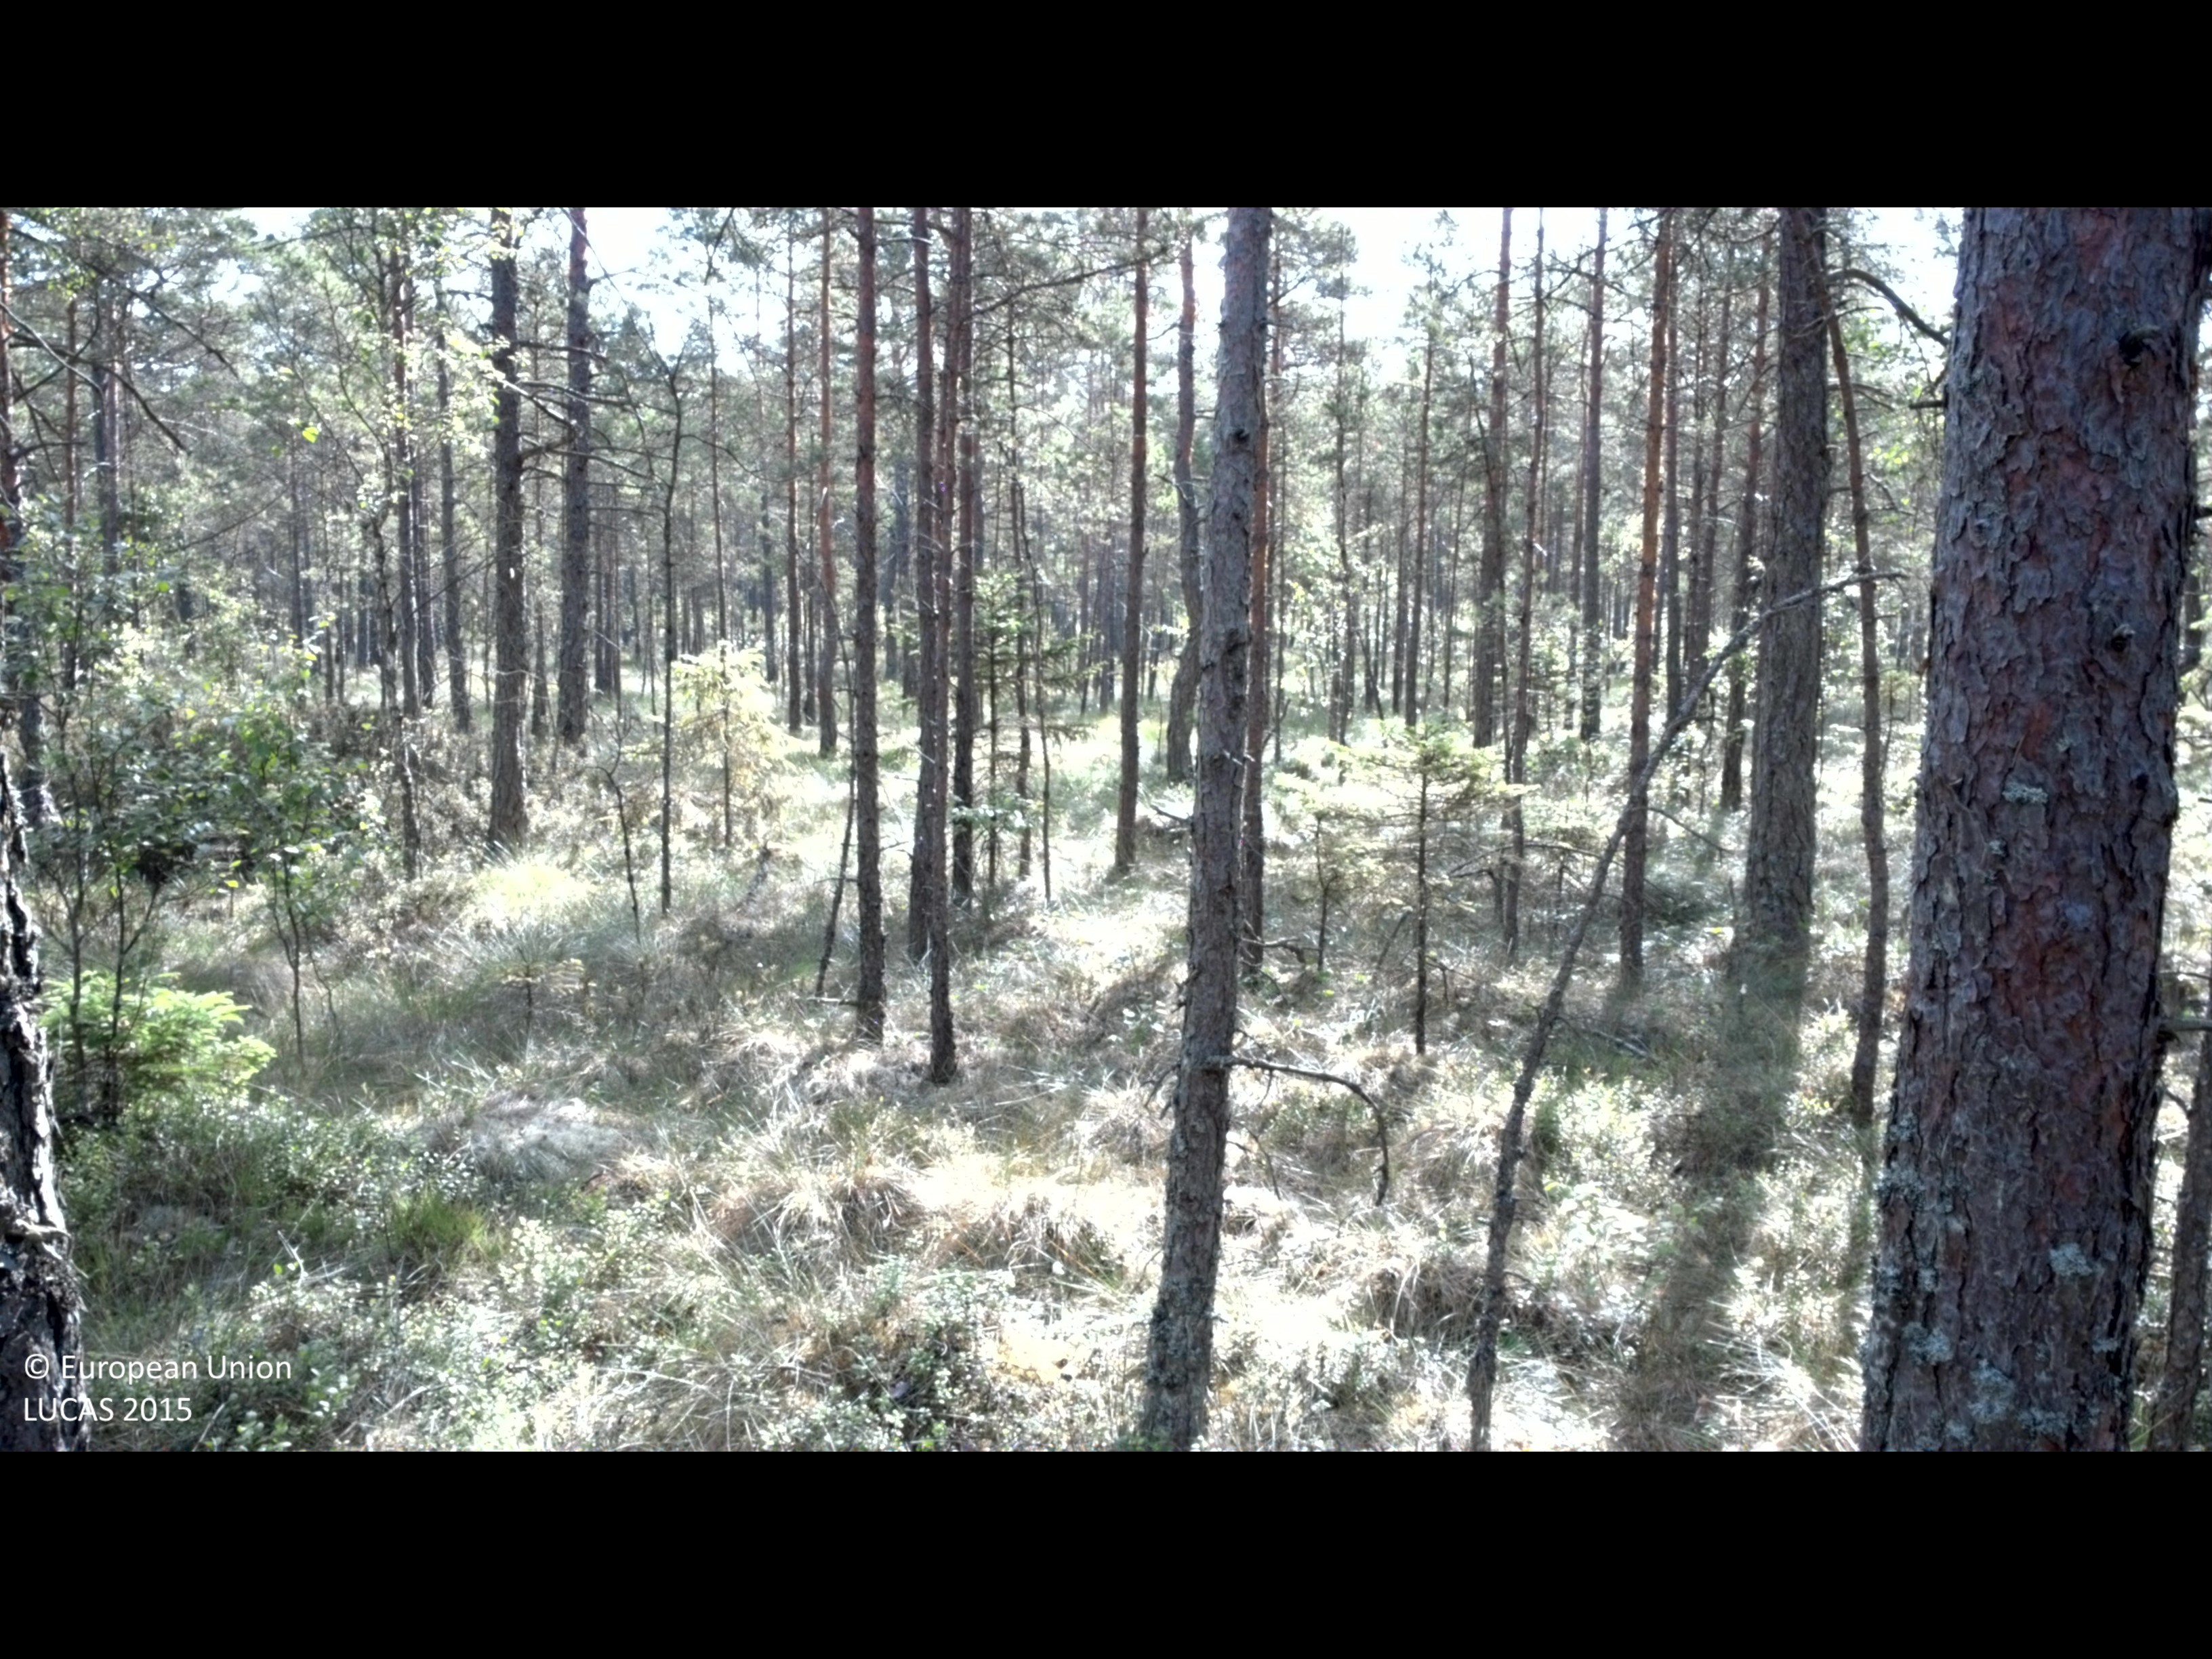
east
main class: Woodland
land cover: Pine dominated coniferous woodland
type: mire and swamp forests
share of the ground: 50 - 75 %
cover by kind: coniferous forest trees 55 %, shrubs 25 %, herbaceous plants 15 %, broadleaved forest trees 5 %
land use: Forestry
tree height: > 5 m
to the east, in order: Pine dominated coniferous woodland; Broadleaved woodland; Spruce dominated coniferous woodland; Spruce dominated mixed woodland
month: July
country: SE
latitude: 56.5645
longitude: 14.3421
